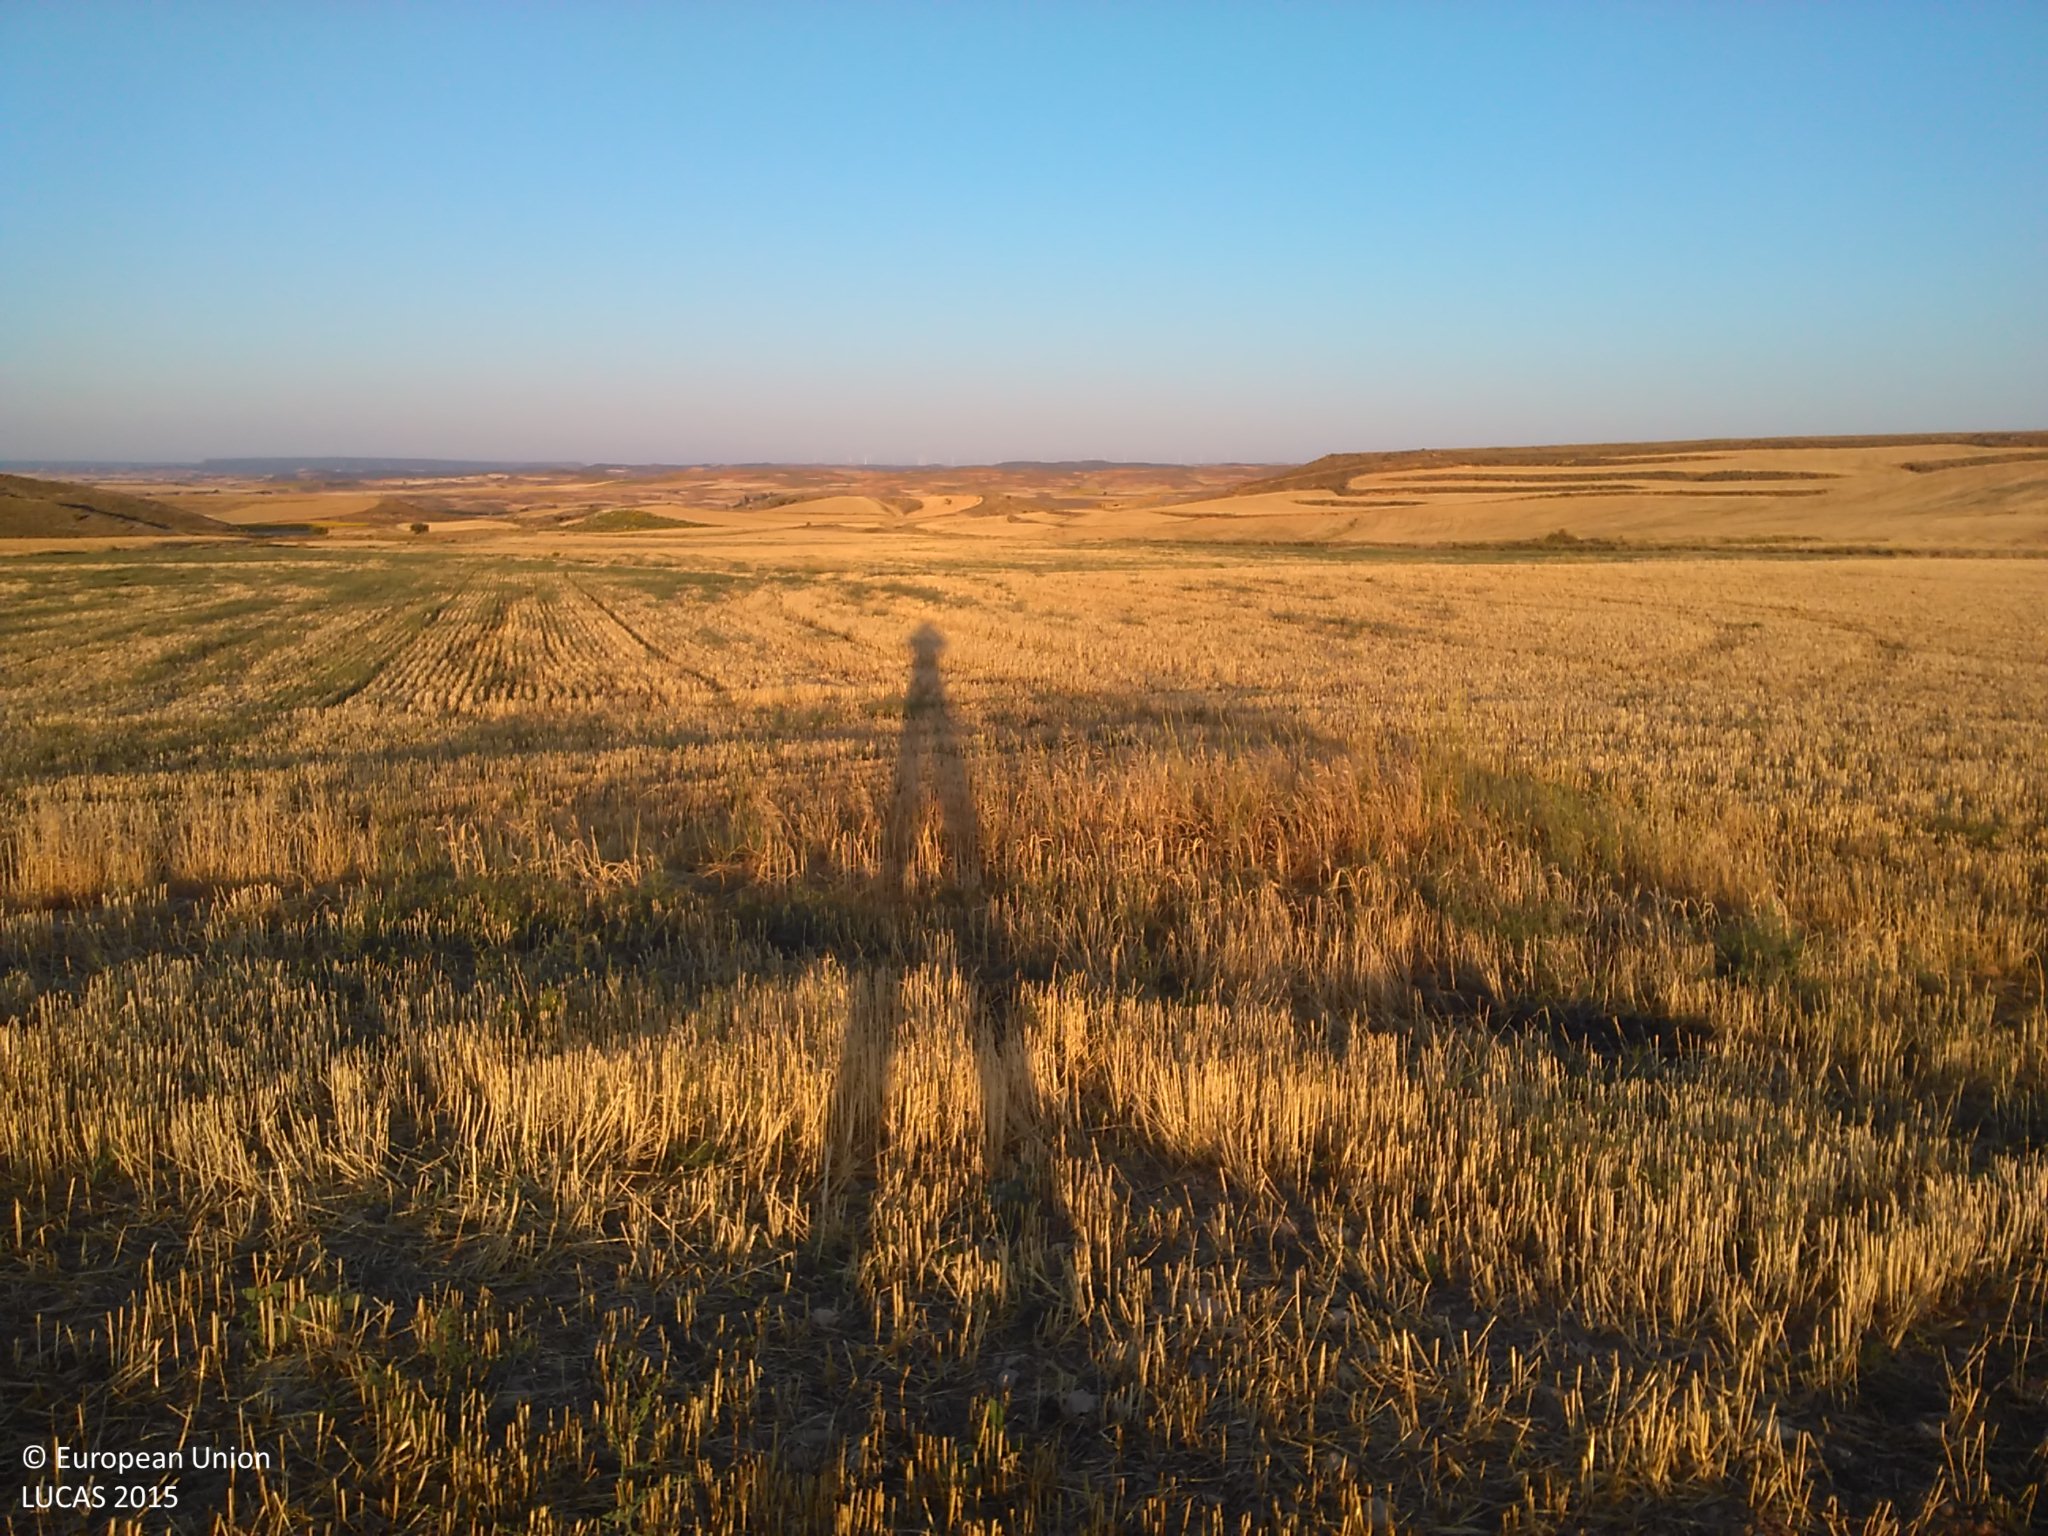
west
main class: Cropland
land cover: Barley
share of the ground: < 10 %
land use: Agriculture (excluding fallow land and kitchen gardens)
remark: Harvested field
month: July
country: ES
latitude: 41.4652
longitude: -2.1360
